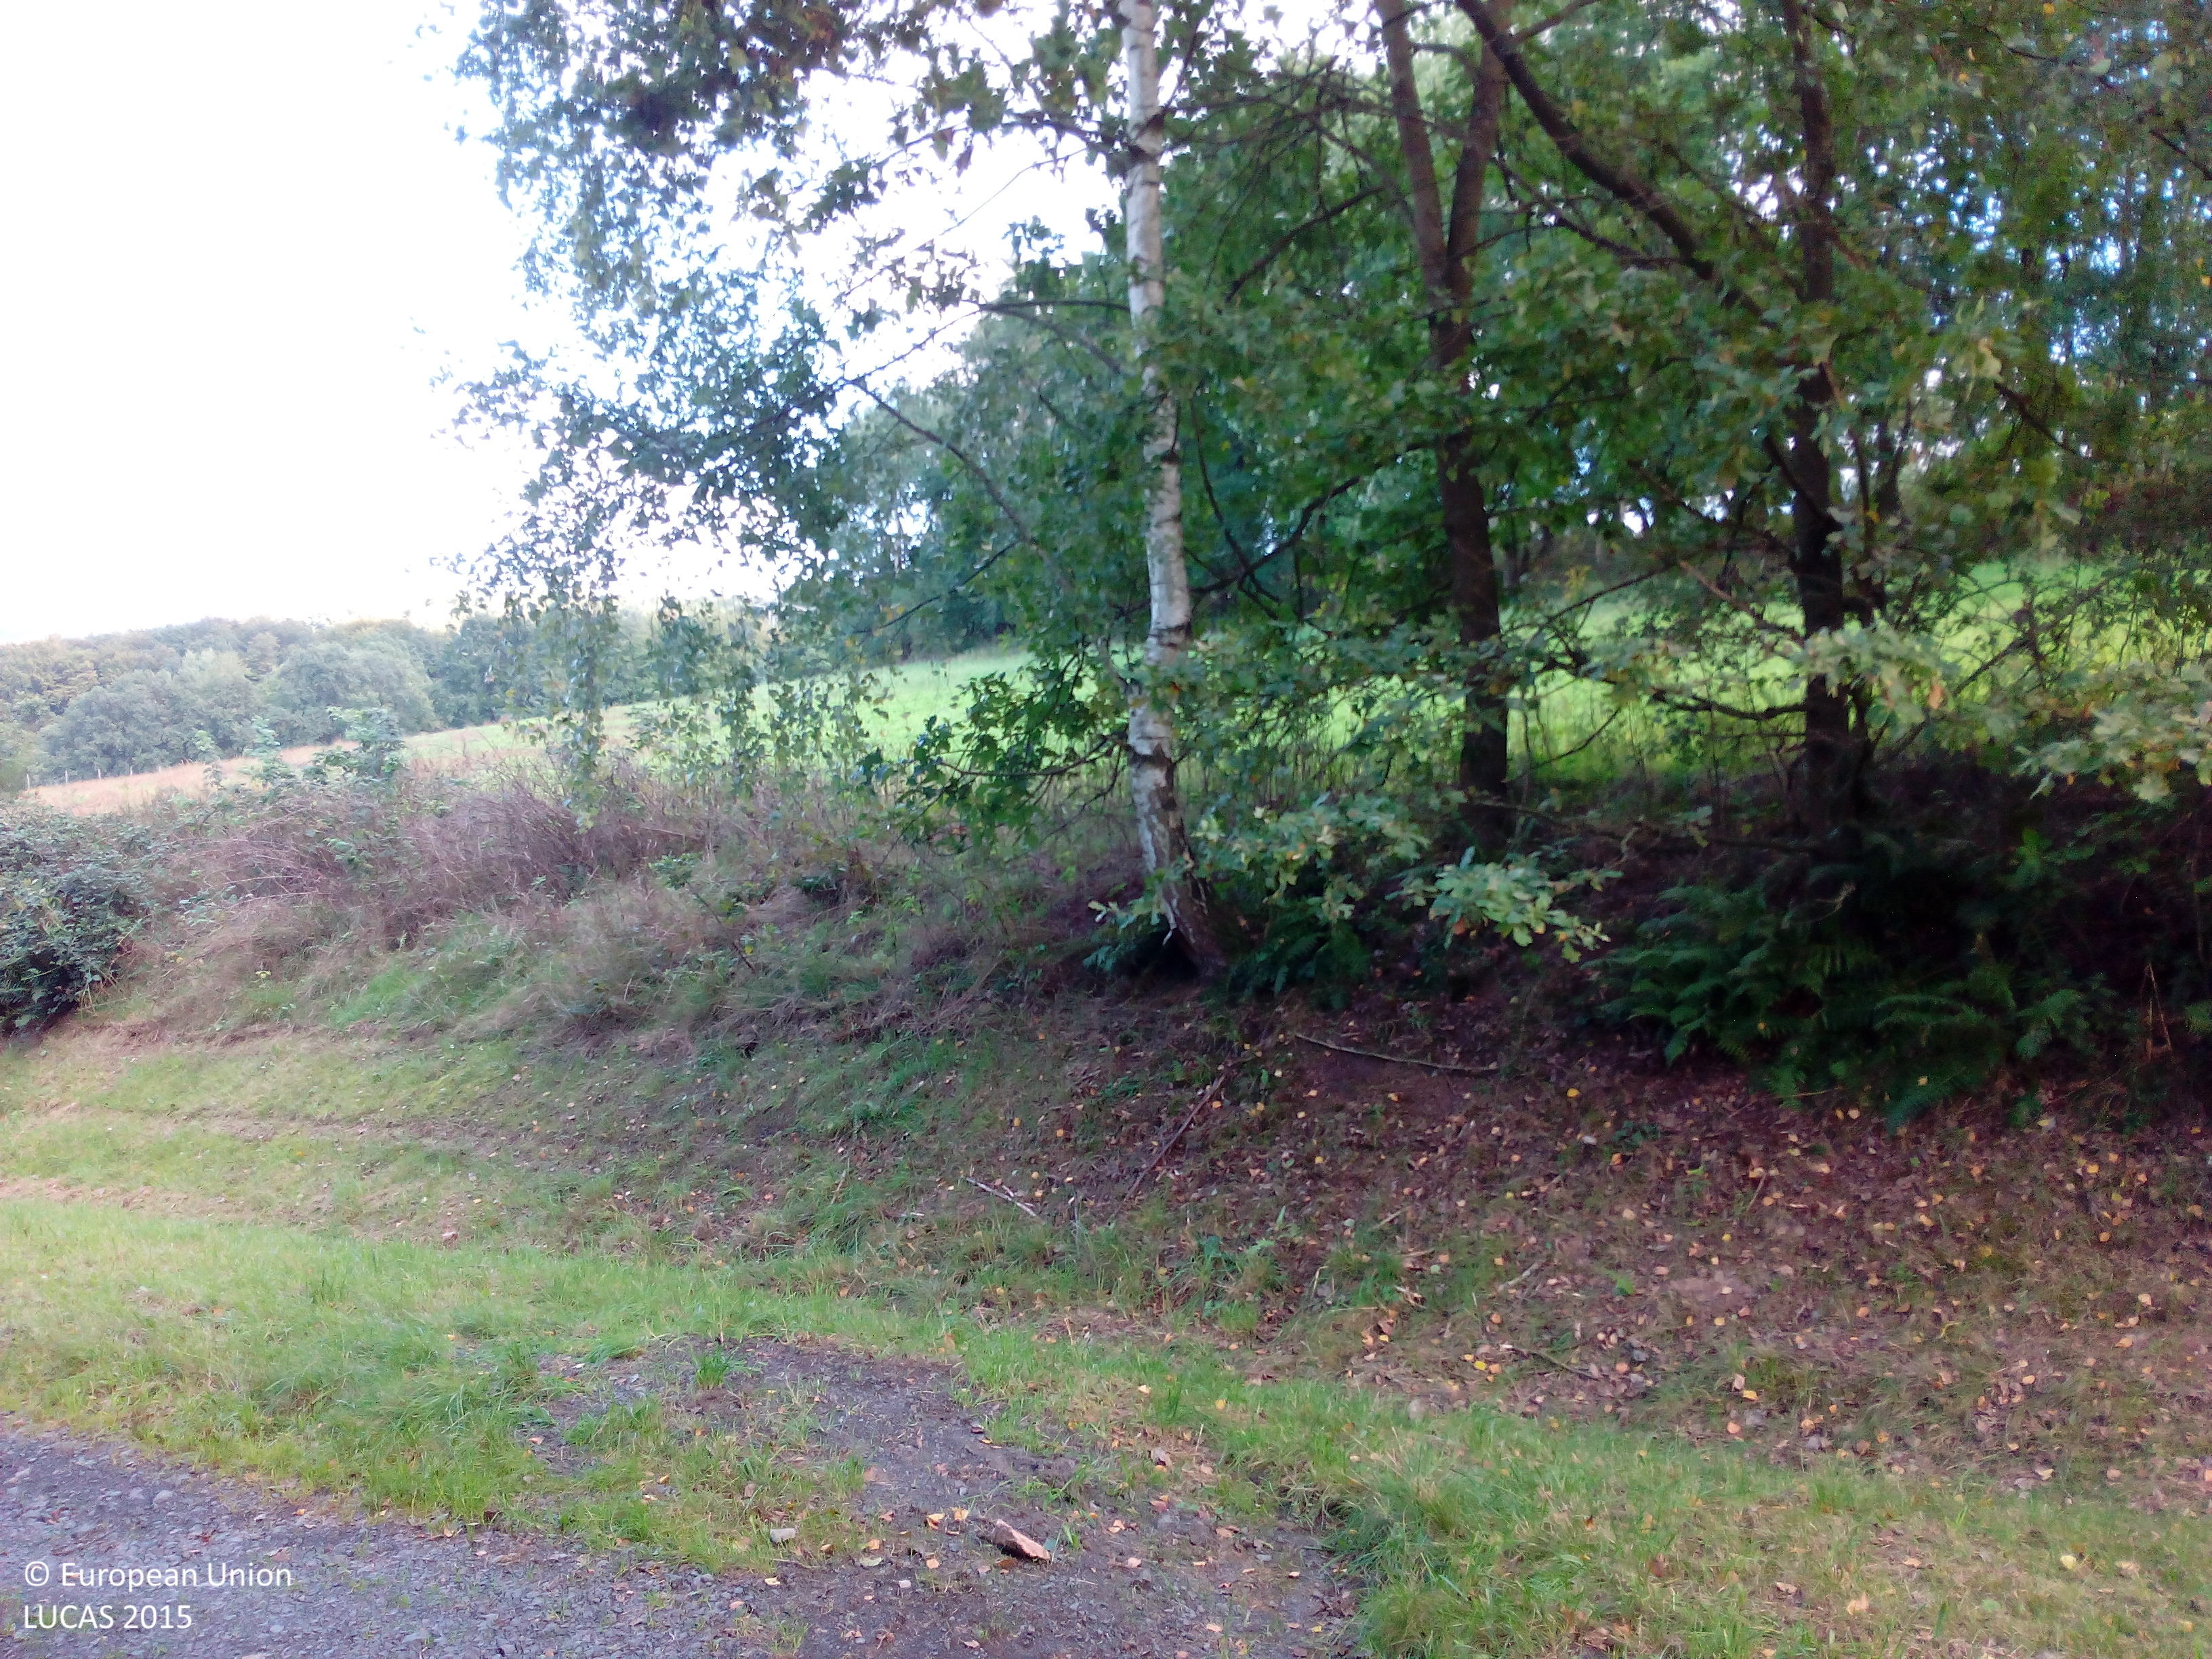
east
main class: Woodland
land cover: Other mixed woodland
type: hemiboreal forest and nemoral coniferous forest and mixed broadleaved-coniferous forest
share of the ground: > 75 %
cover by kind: coniferous forest trees 60 %, broadleaved forest trees 20 %, herbaceous plants 15 %, shrubs 5 %
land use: Semi-natural and natural areas not in use
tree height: > 5 m
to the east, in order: Other mixed woodland; Fences; Grassland with sparse tree/shrub cover; Temporary grasslands; Broadleaved woodland; Tracks; Spontaneously vegetated surfaces; Grassland with sparse tree/shrub cover; Grassland without tree/shrub cover
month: September
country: DE
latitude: 50.2542
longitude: 9.3410
